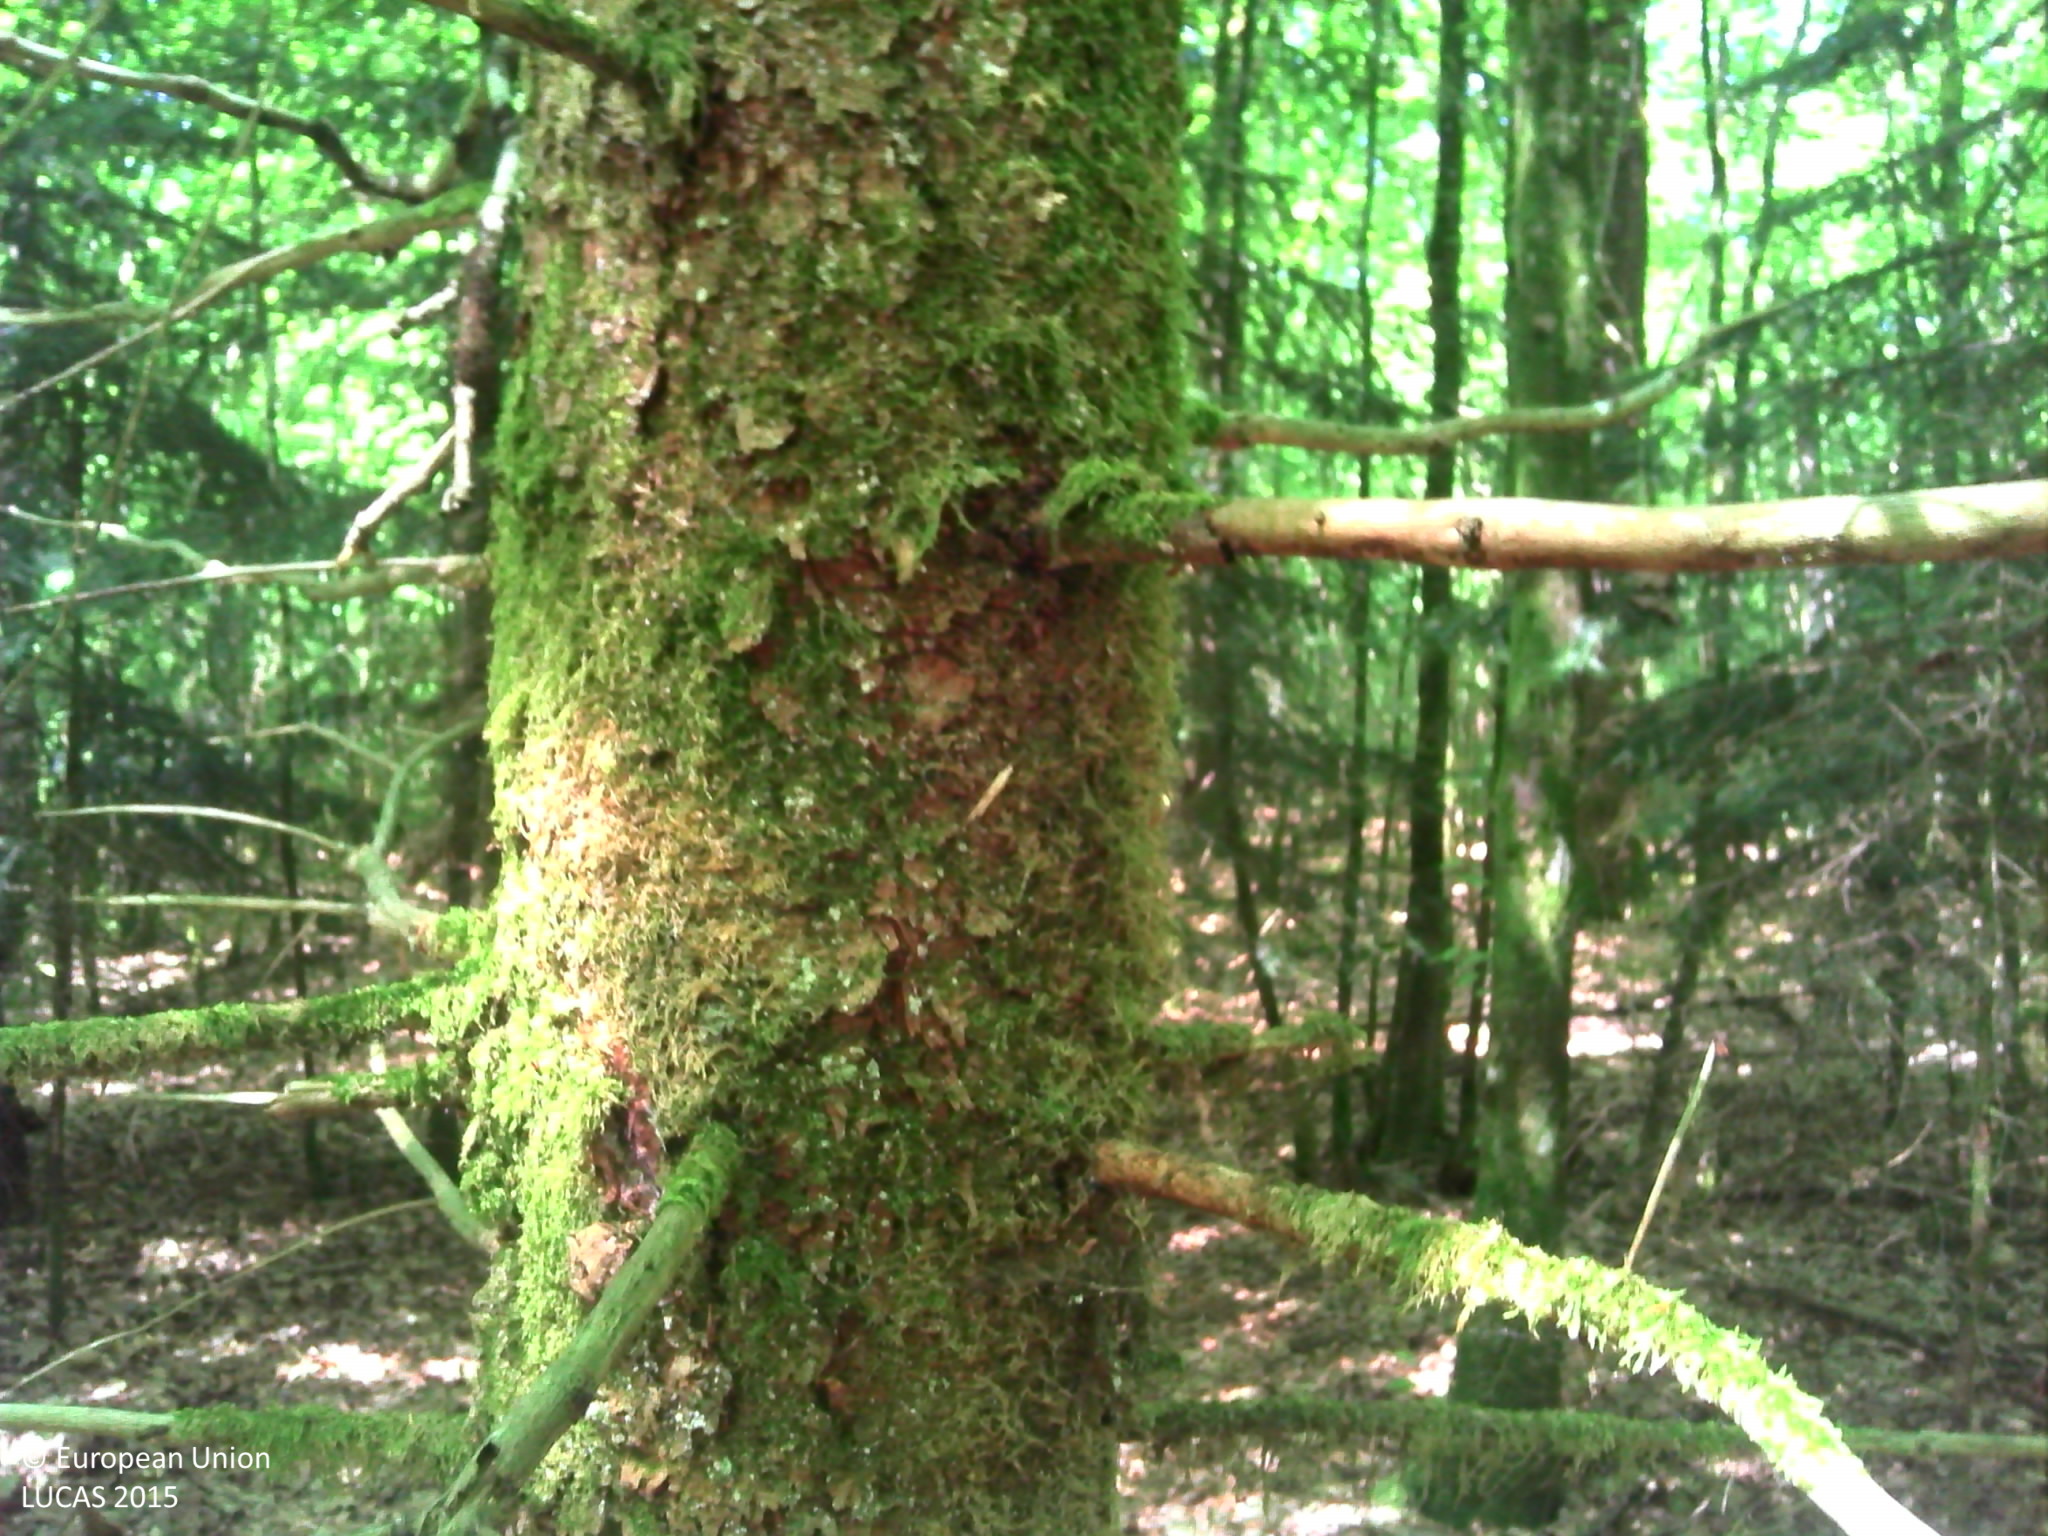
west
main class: Woodland
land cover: Spruce dominated mixed woodland
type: mesophytic deciduous forest
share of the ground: > 75 %
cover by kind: broadleaved forest trees 50 %, coniferous forest trees 45 %, herbaceous plants 5 %
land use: Forestry
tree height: > 5 m
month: June
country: FR
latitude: 48.4673
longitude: 4.9264
